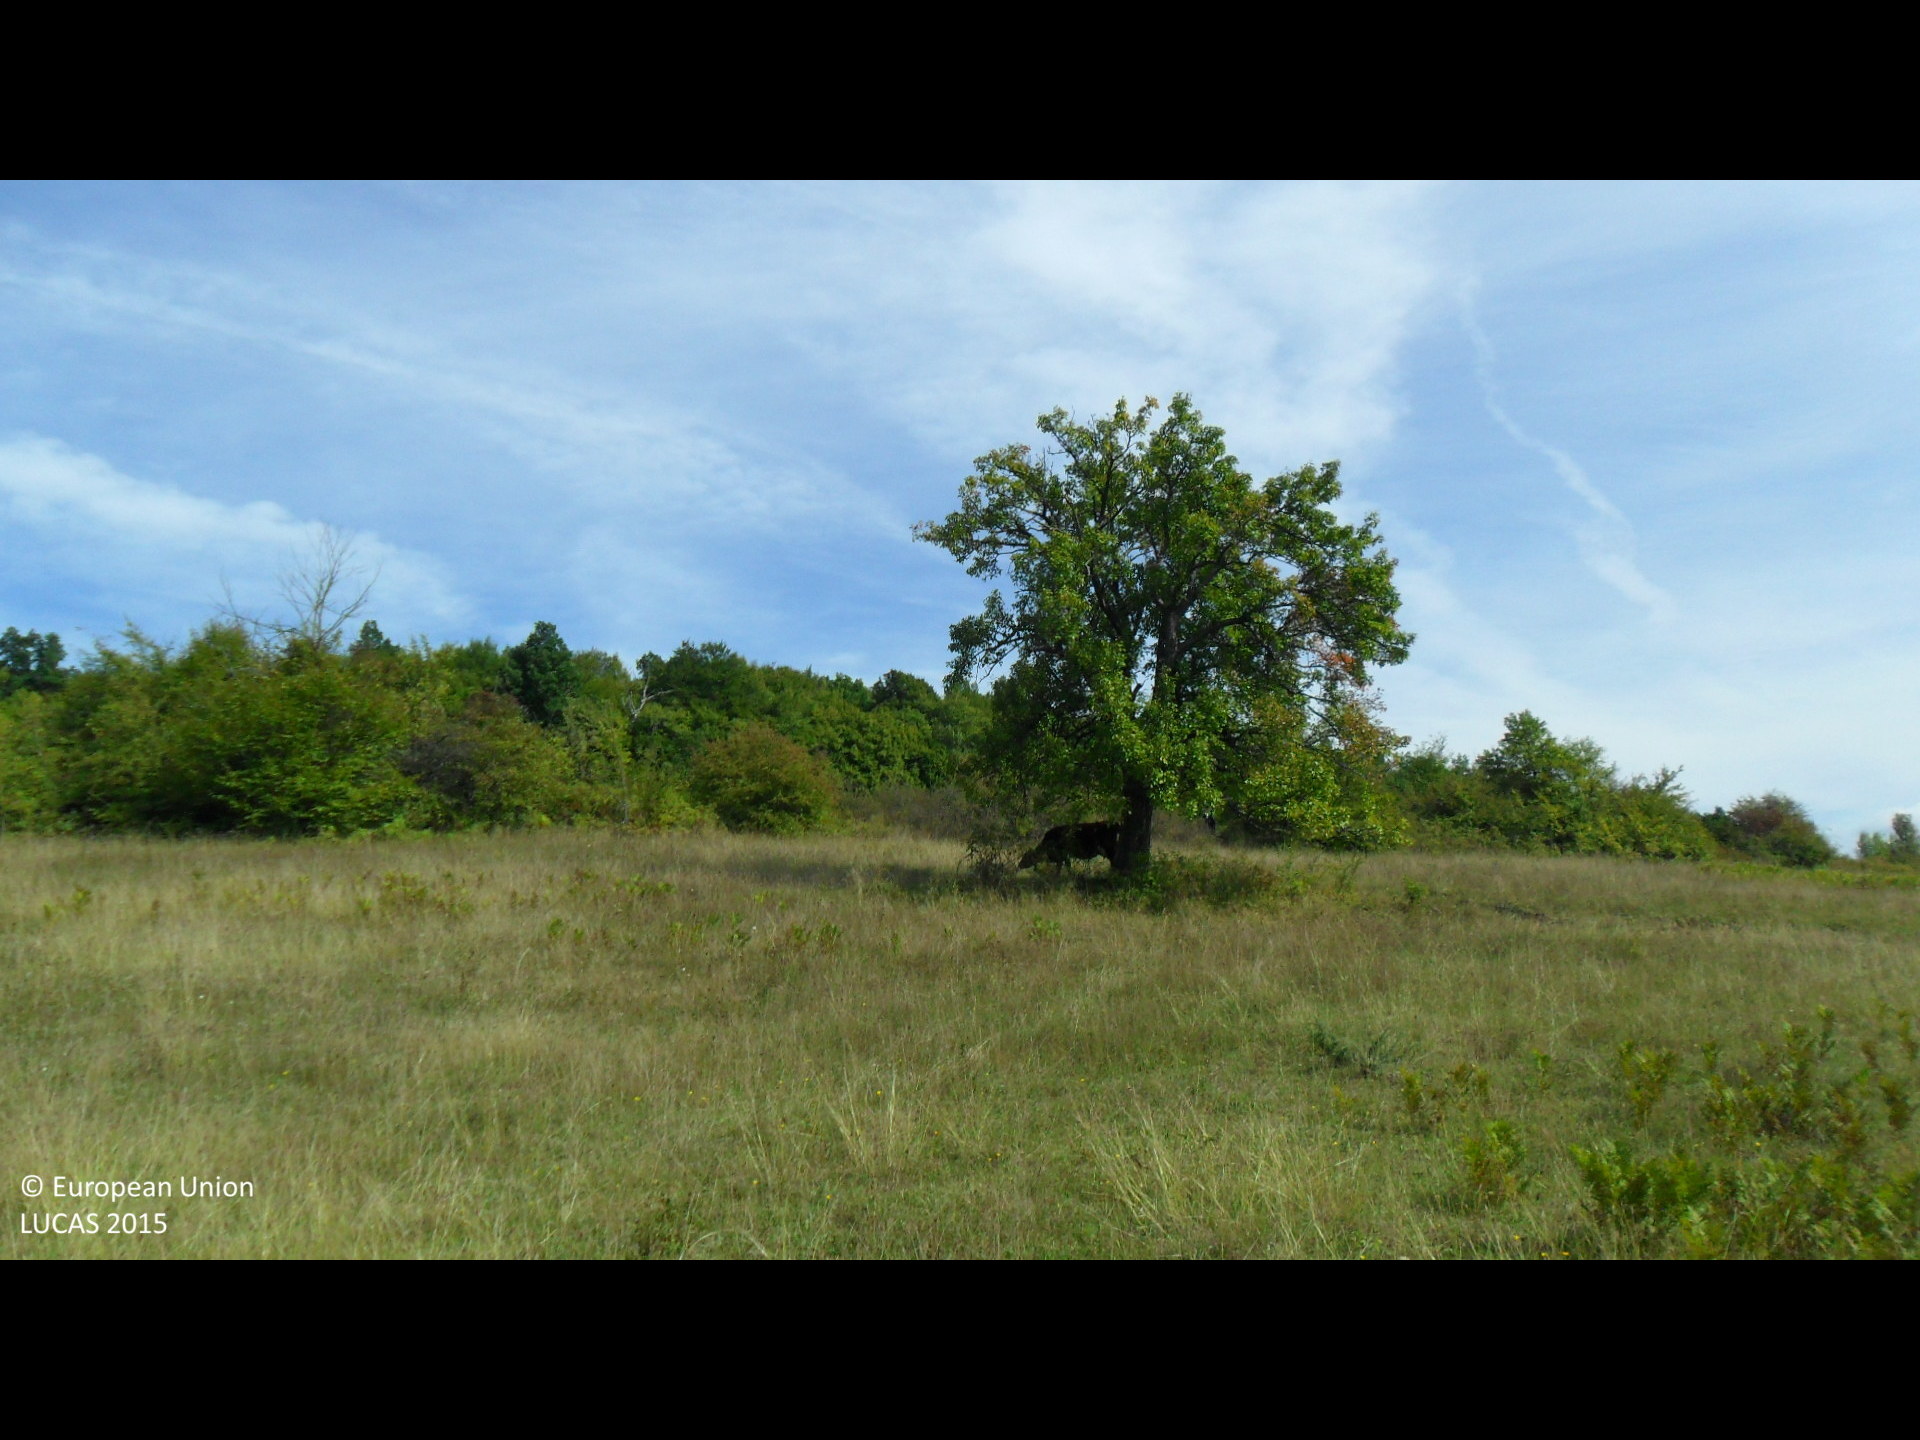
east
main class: Shrubland
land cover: Shrubland without tree cover
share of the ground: > 75 %
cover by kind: shrubs 80 %, herbaceous plants 20 %
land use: Agriculture (excluding fallow land and kitchen gardens)
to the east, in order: Shrubland without tree cover; Grassland without tree/shrub cover; Shrubland without tree cover; Grassland without tree/shrub cover; Broadleaved woodland
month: October
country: BG
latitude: 42.9769
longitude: 26.1912
